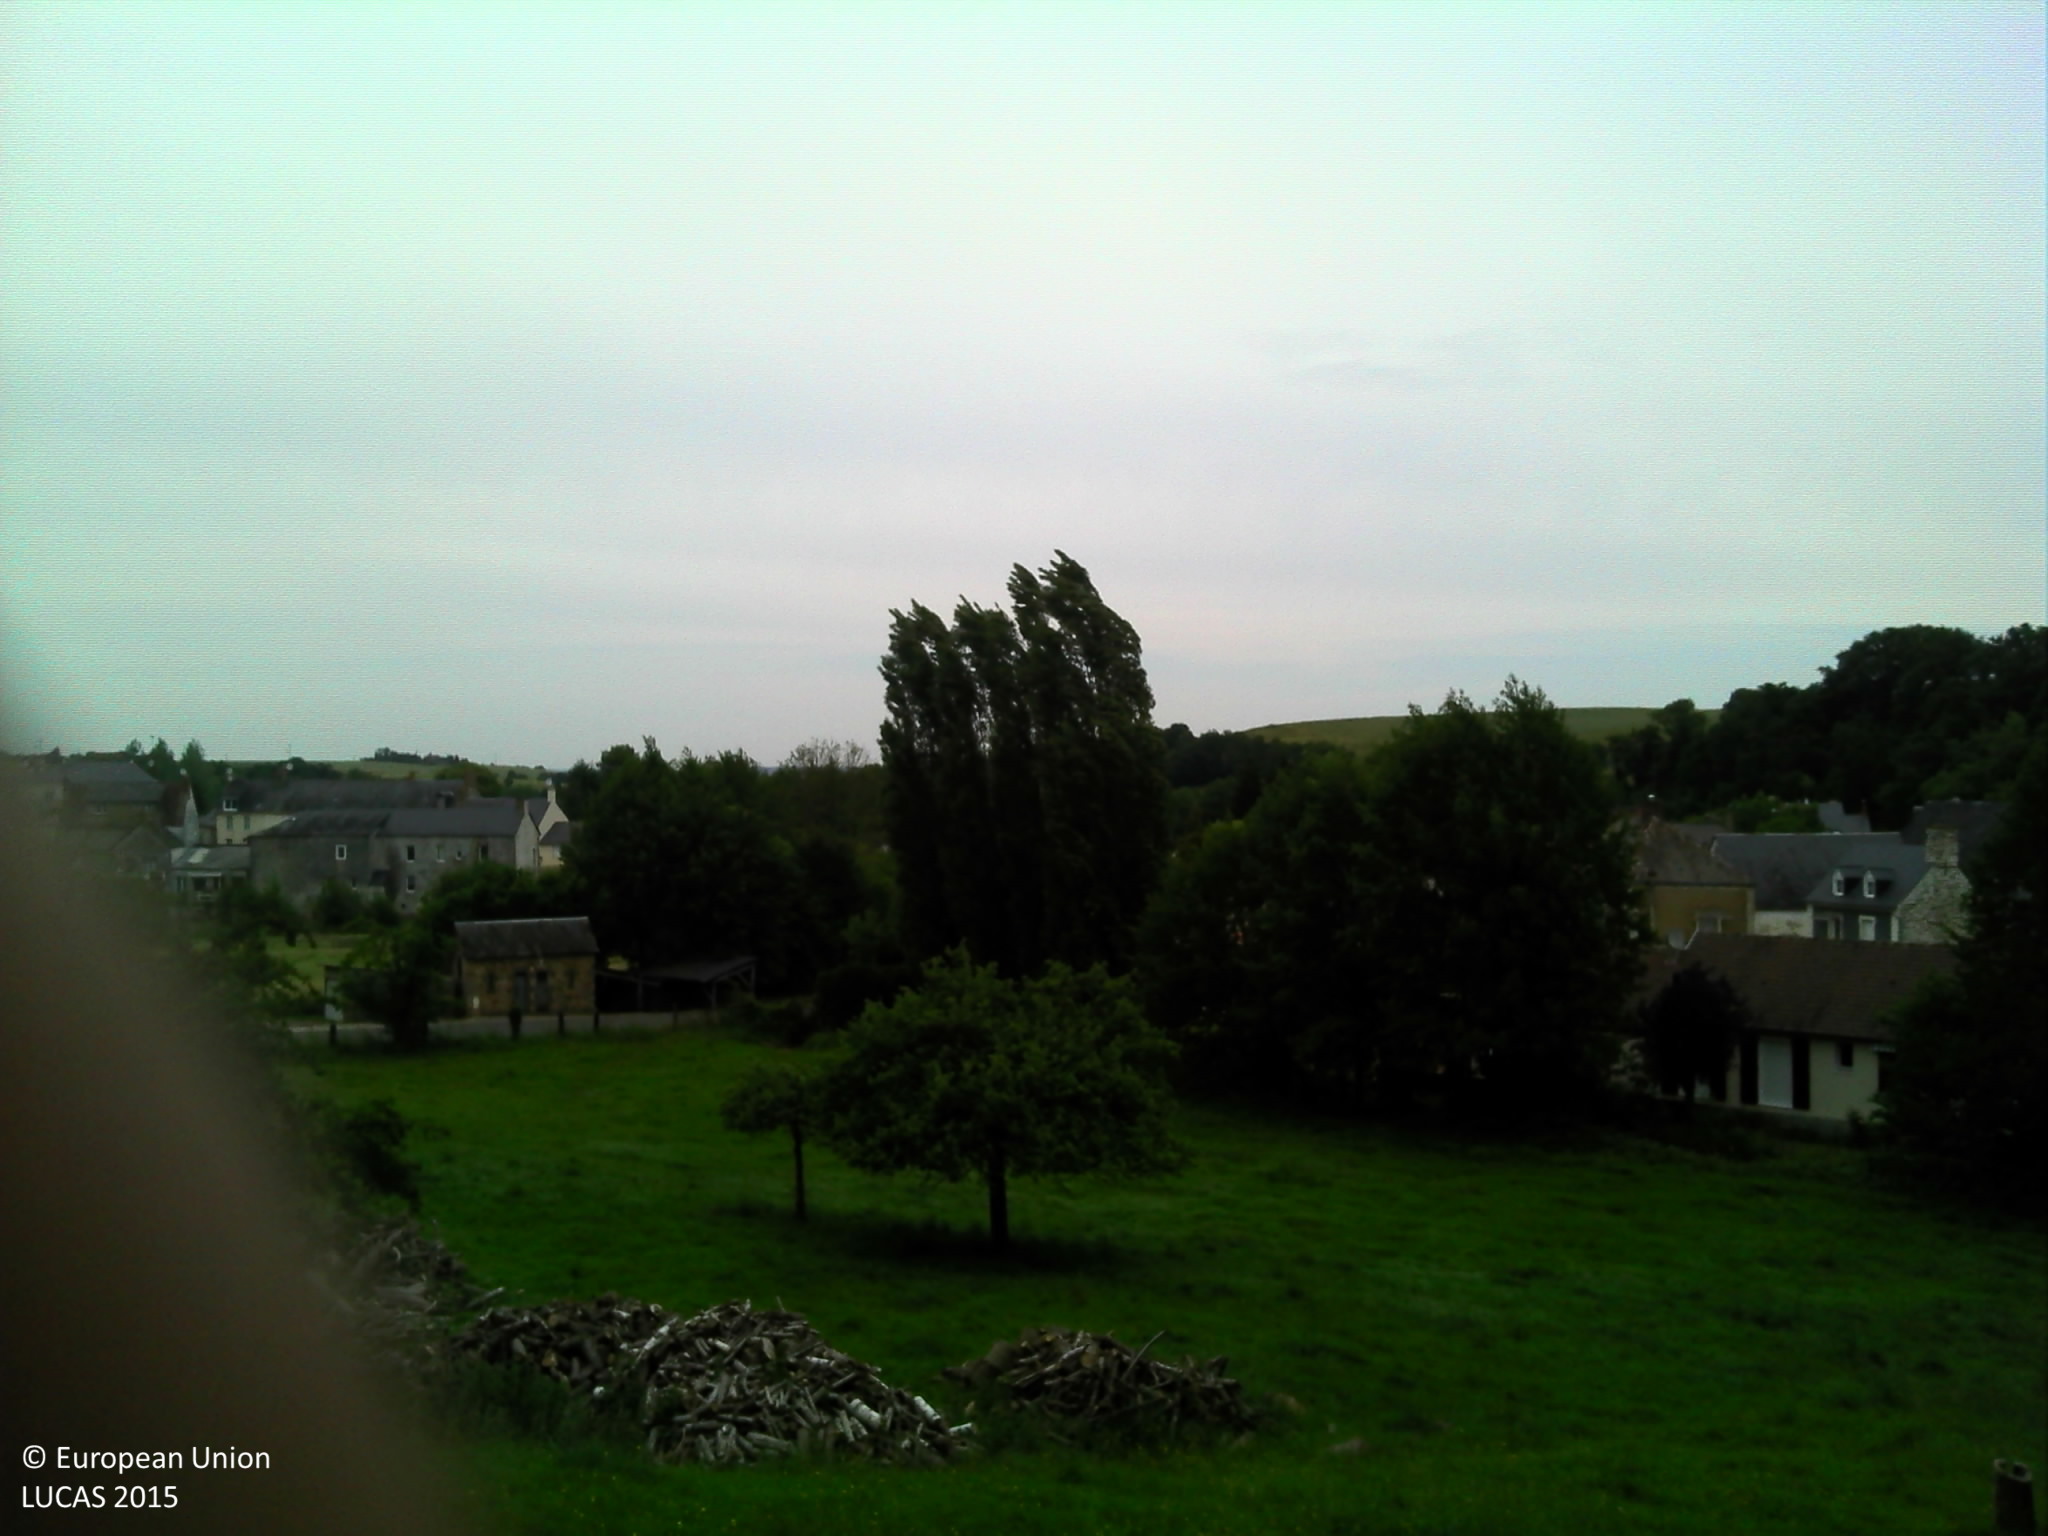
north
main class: Grassland
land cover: Grassland with sparse tree/shrub cover
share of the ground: > 75 %
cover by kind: herbaceous plants 95 %, broadleaved forest trees 5 %
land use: Agriculture (excluding fallow land and kitchen gardens)
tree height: > 5 m
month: June
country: FR
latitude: 48.2717
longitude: -0.0400
